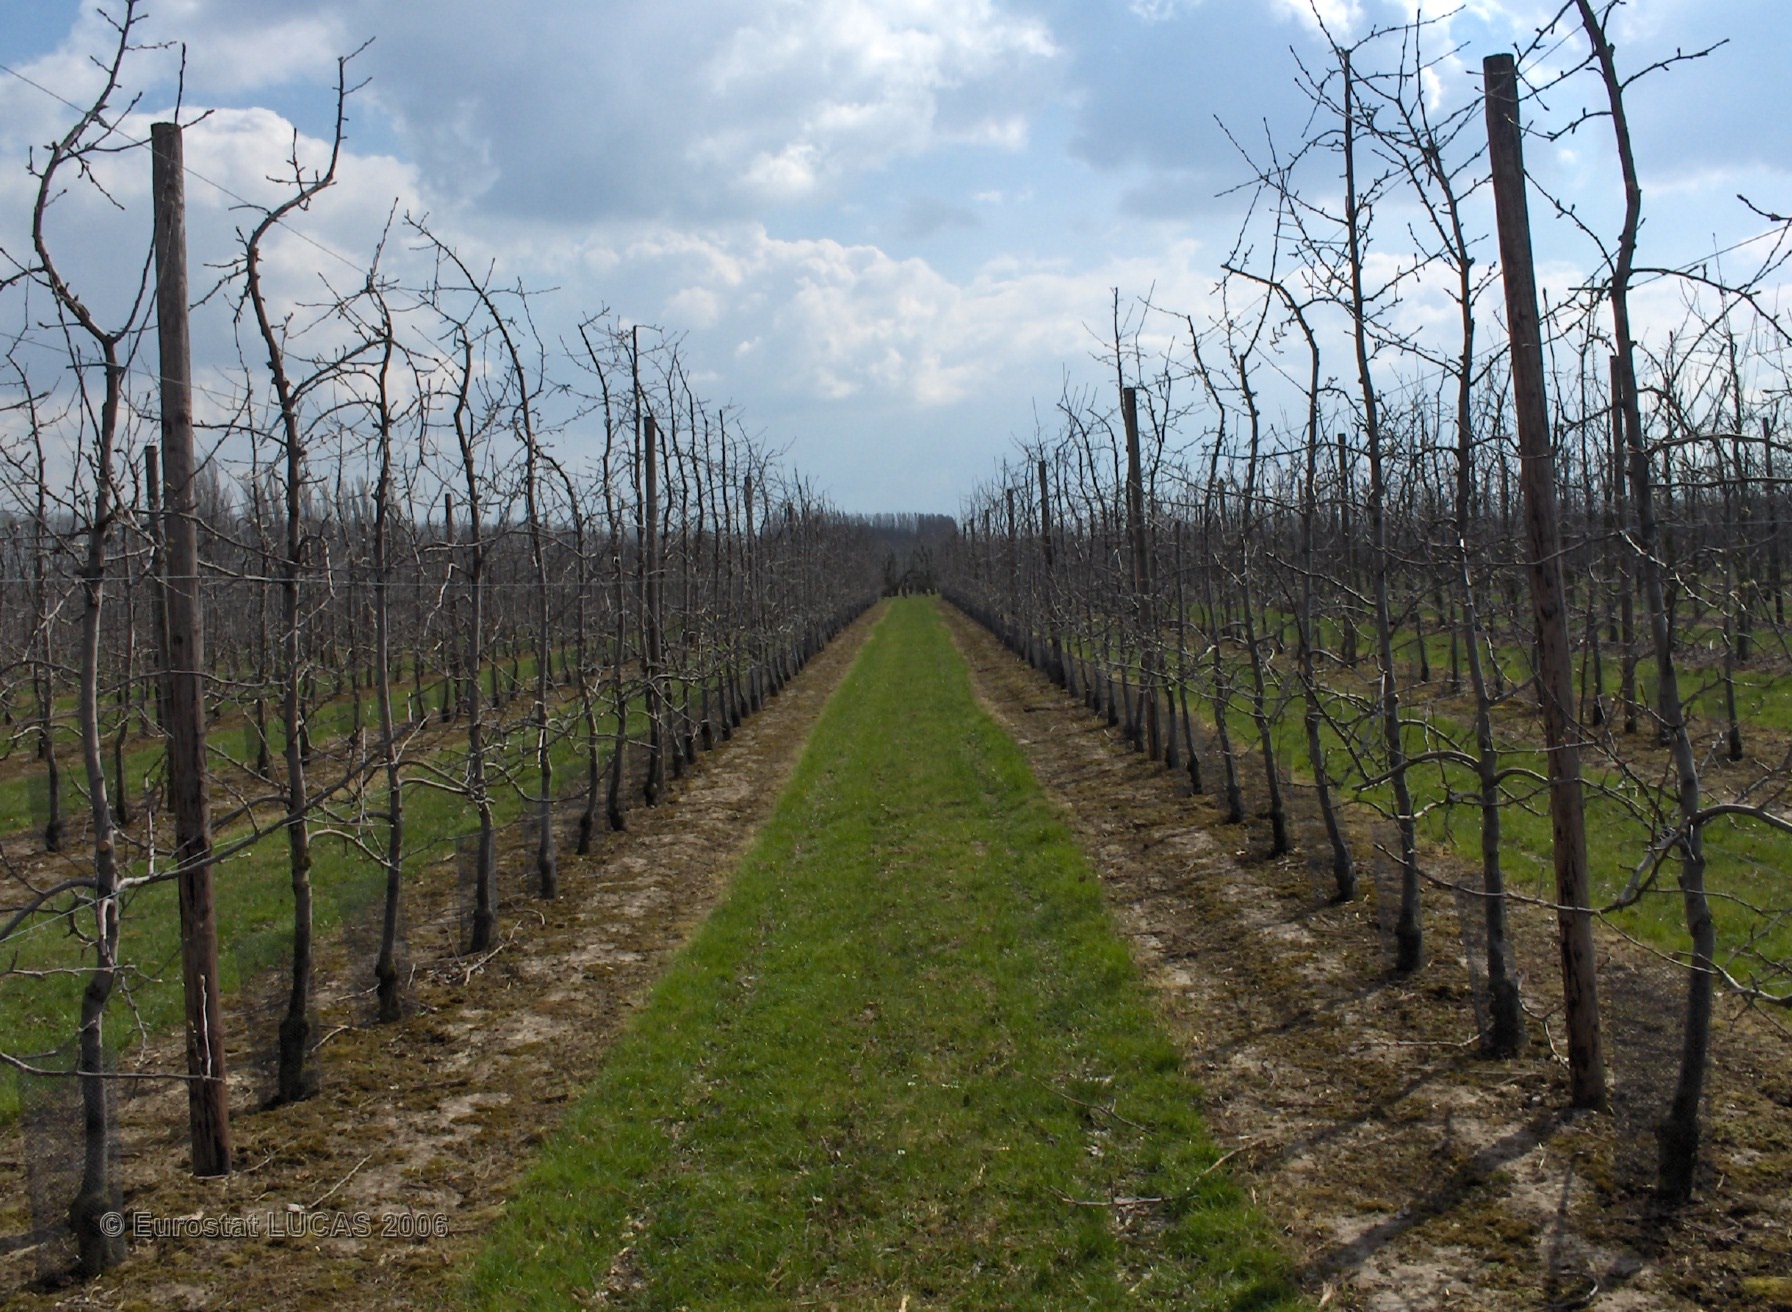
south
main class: Cropland
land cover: Apple fruit
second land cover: Grassland with sparse tree/shrub cover
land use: Agriculture (excluding fallow land and kitchen gardens)
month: April
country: BE
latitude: 50.8032
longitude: 5.1873
